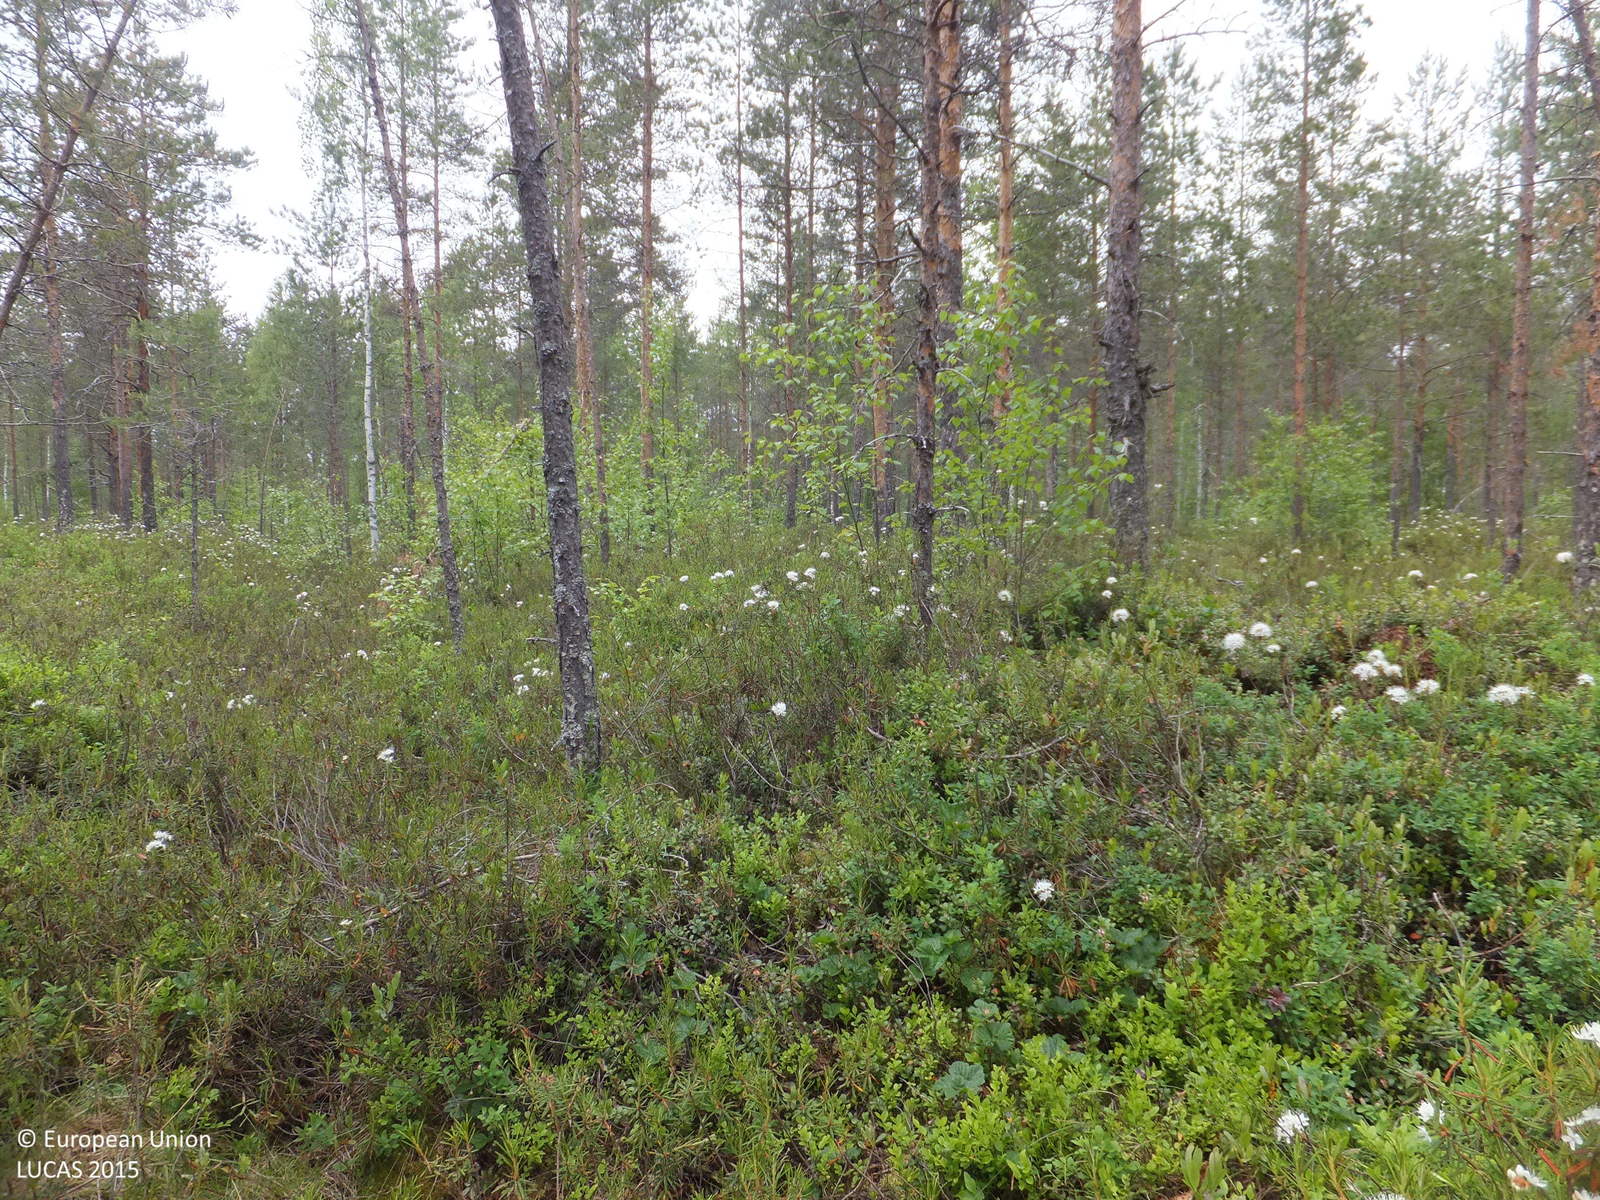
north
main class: Woodland
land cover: Pine dominated mixed woodland
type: boreal forest
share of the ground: 50 - 75 %
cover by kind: coniferous forest trees 40 %, shrubs 30 %, broadleaved forest trees 25 %, lichens and mosses 5 %
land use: Forestry
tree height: > 5 m
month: June
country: FI
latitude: 63.5193
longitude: 24.1644
